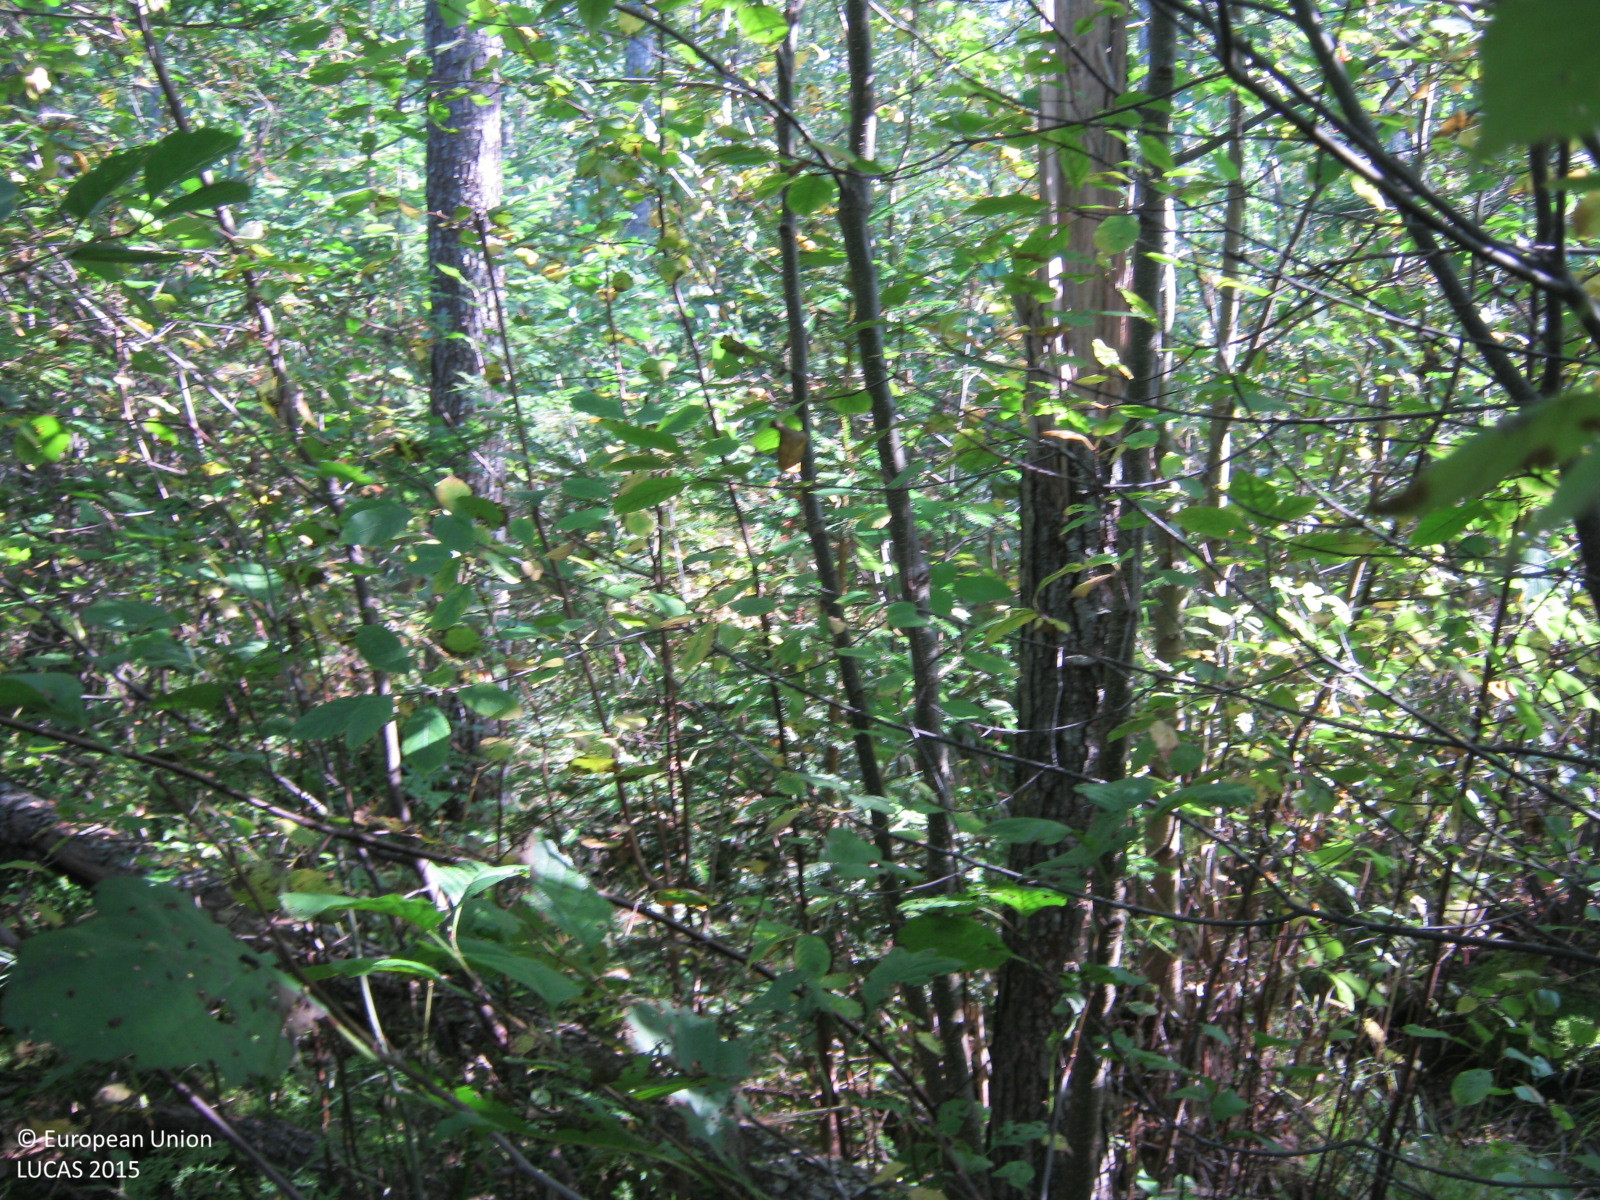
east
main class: Woodland
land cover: Broadleaved woodland
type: non-riverine alder, birch or aspen forest
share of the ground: > 75 %
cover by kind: broadleaved forest trees 90 %, herbaceous plants 10 %
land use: Forestry
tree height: > 5 m
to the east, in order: Broadleaved woodland; Spruce dominated mixed woodland; Broadleaved woodland
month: September
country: LV
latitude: 57.4062
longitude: 24.5229
